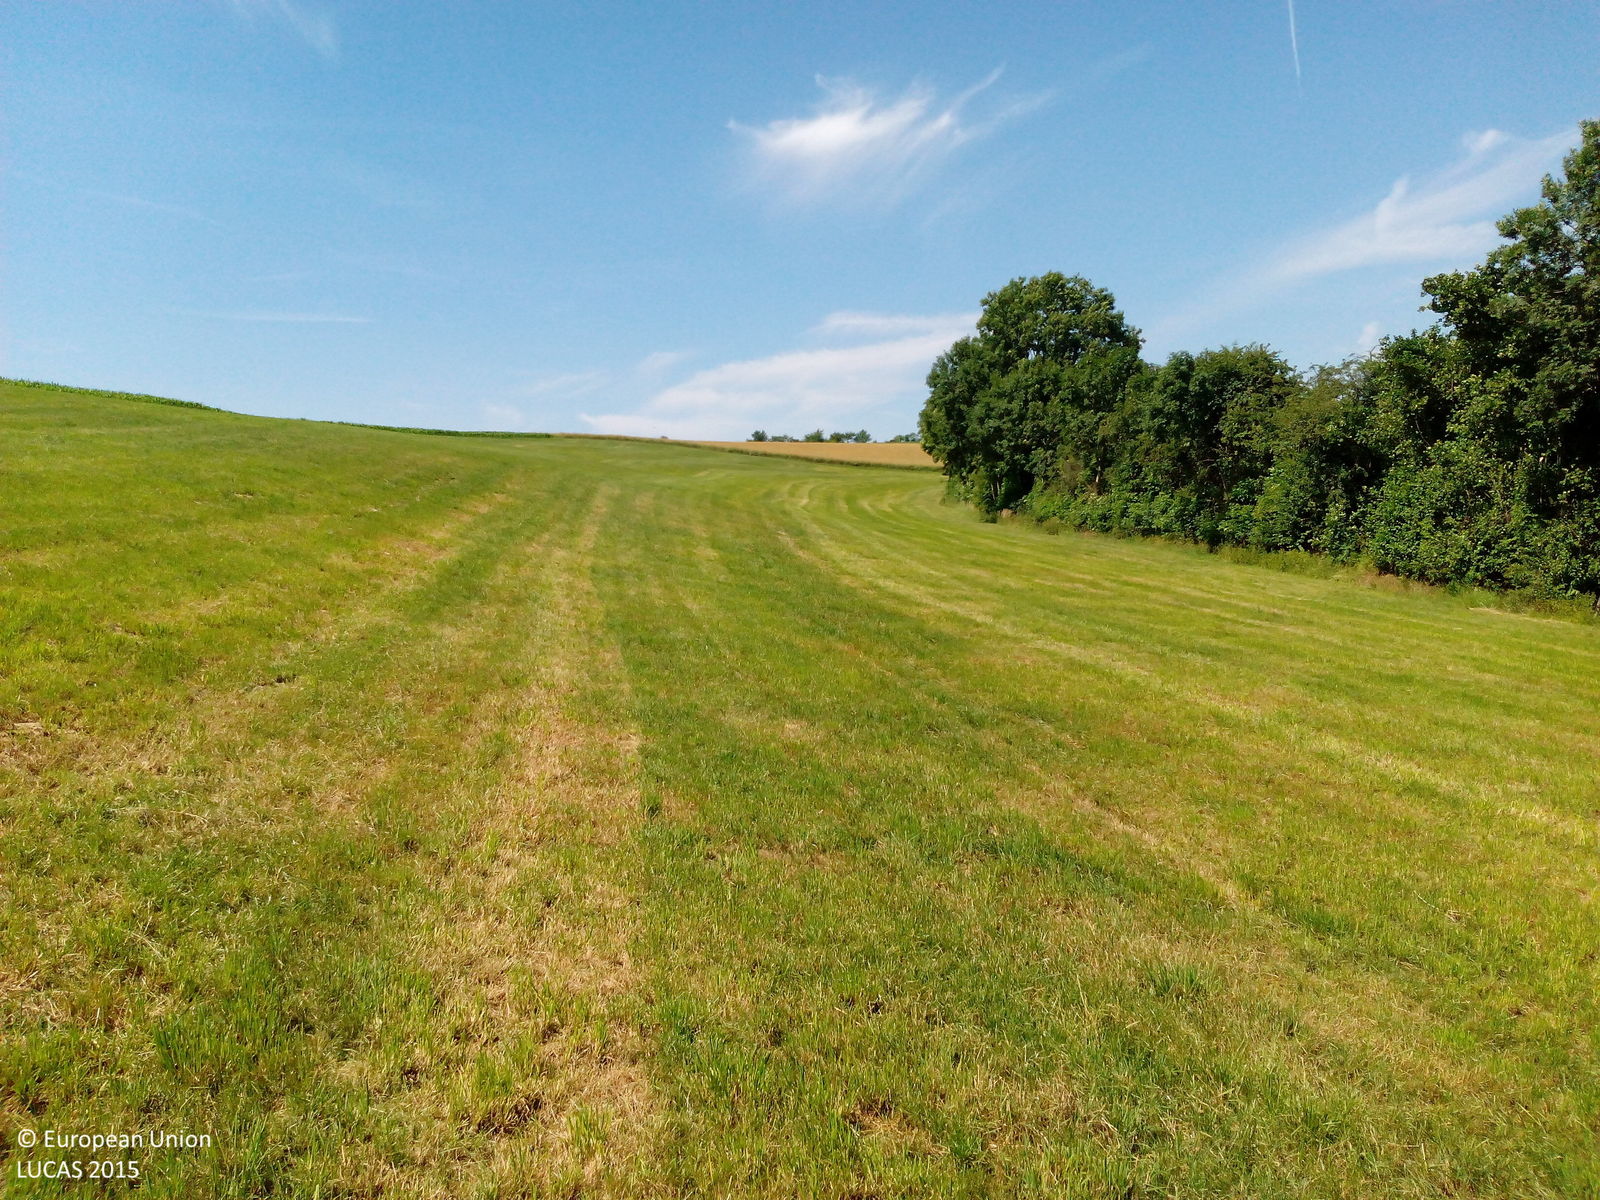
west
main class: Grassland
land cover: Grassland without tree/shrub cover
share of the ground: > 75 %
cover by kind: herbaceous plants 100 %
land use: Agriculture (excluding fallow land and kitchen gardens)
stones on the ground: < 10 %
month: July
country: DE
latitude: 51.7123
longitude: 9.8408
